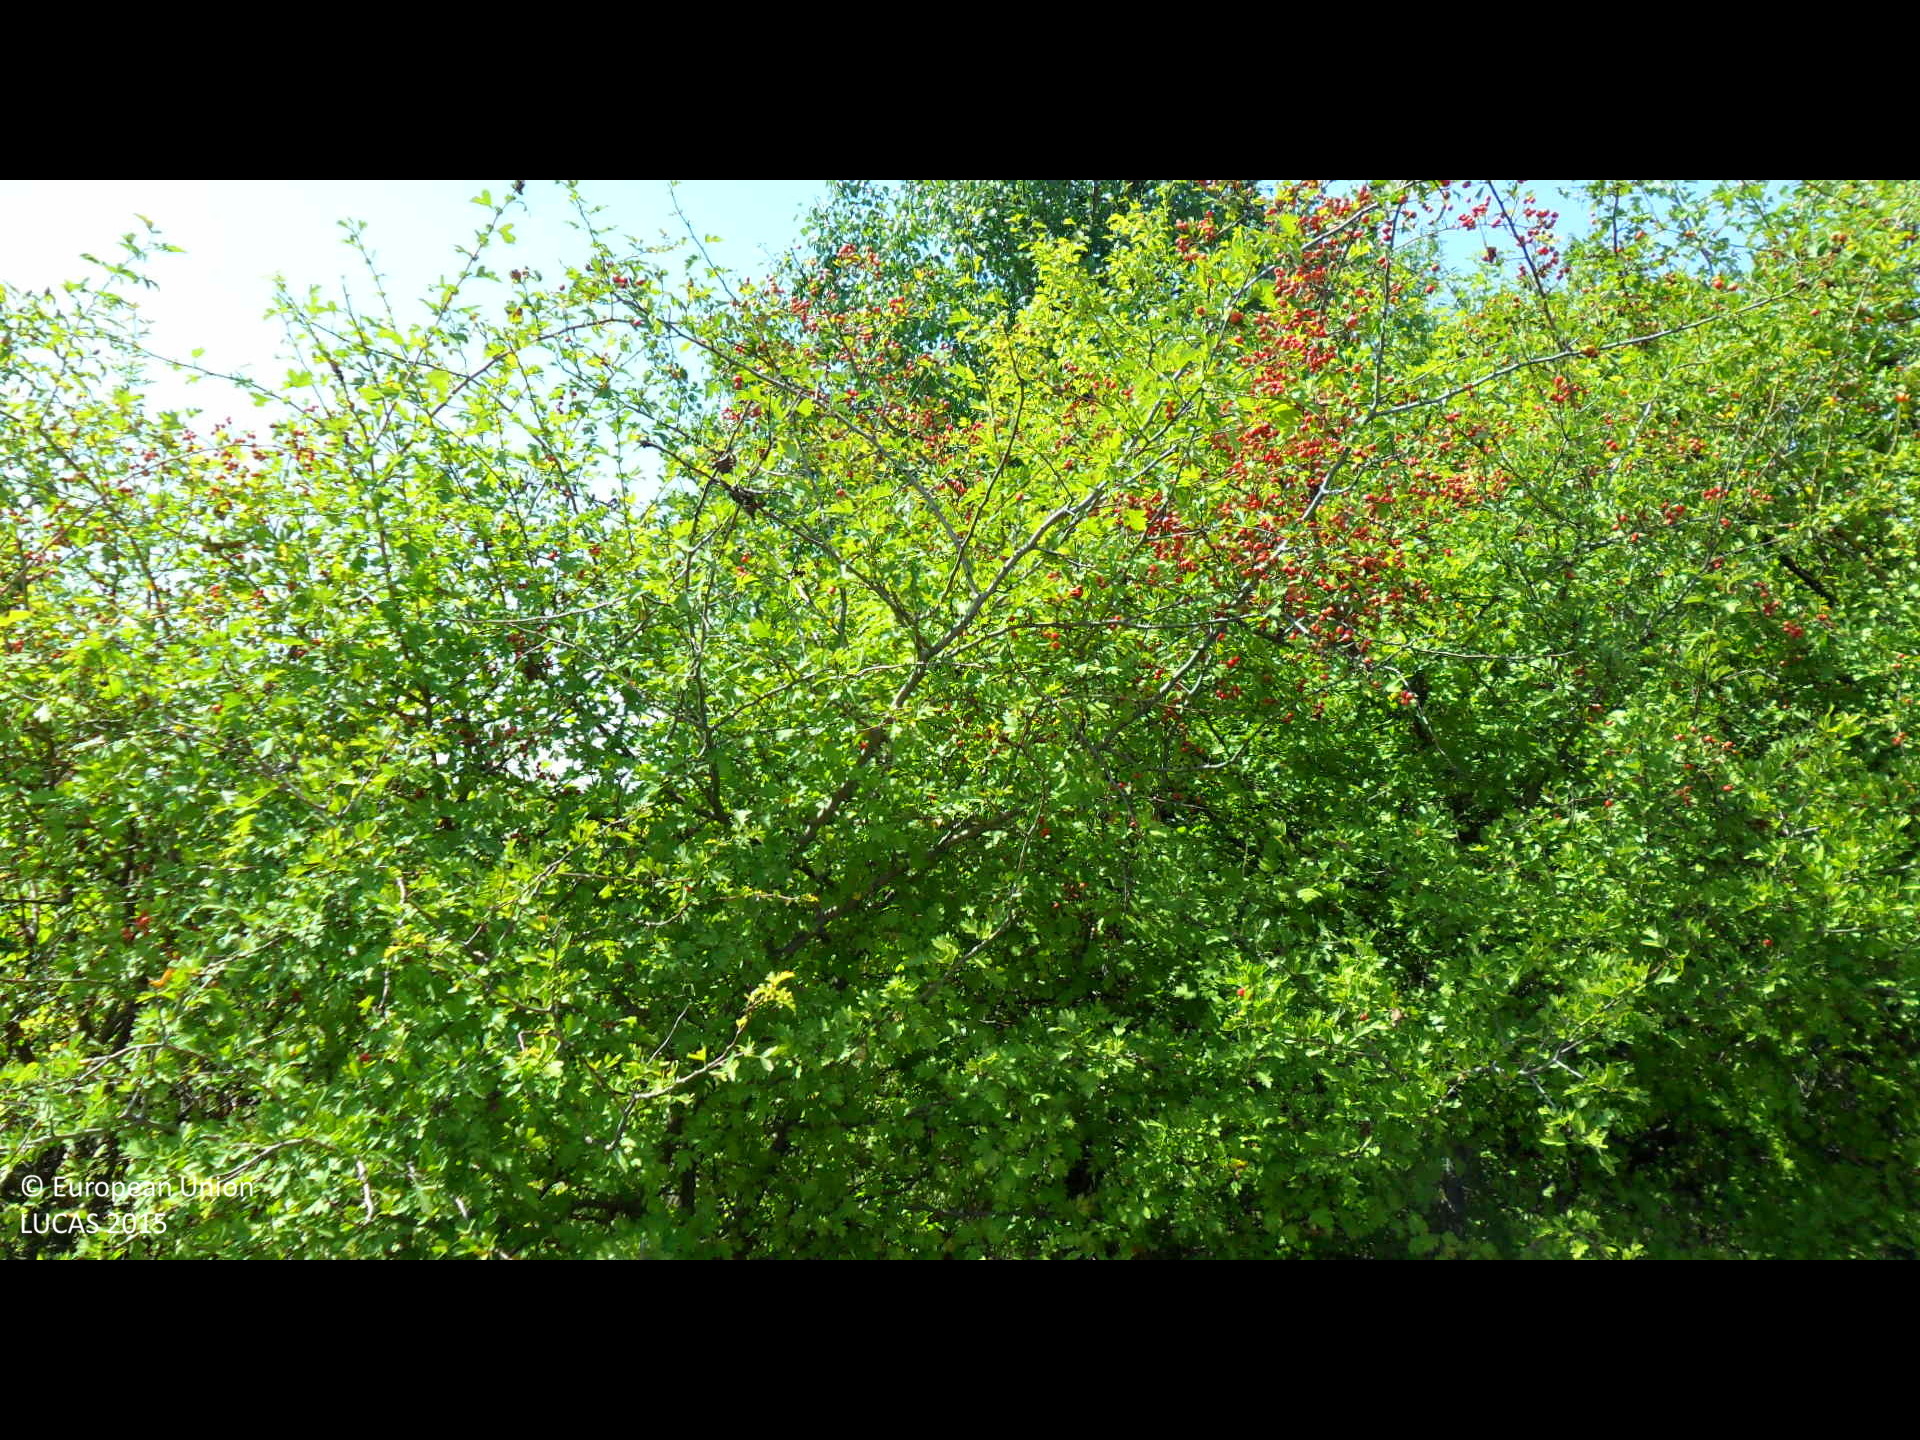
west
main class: Shrubland
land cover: Shrubland without tree cover
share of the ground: > 75 %
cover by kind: shrubs 75 %, herbaceous plants 25 %
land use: Semi-natural and natural areas not in use
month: August
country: BG
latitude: 43.4630
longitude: 26.2526
